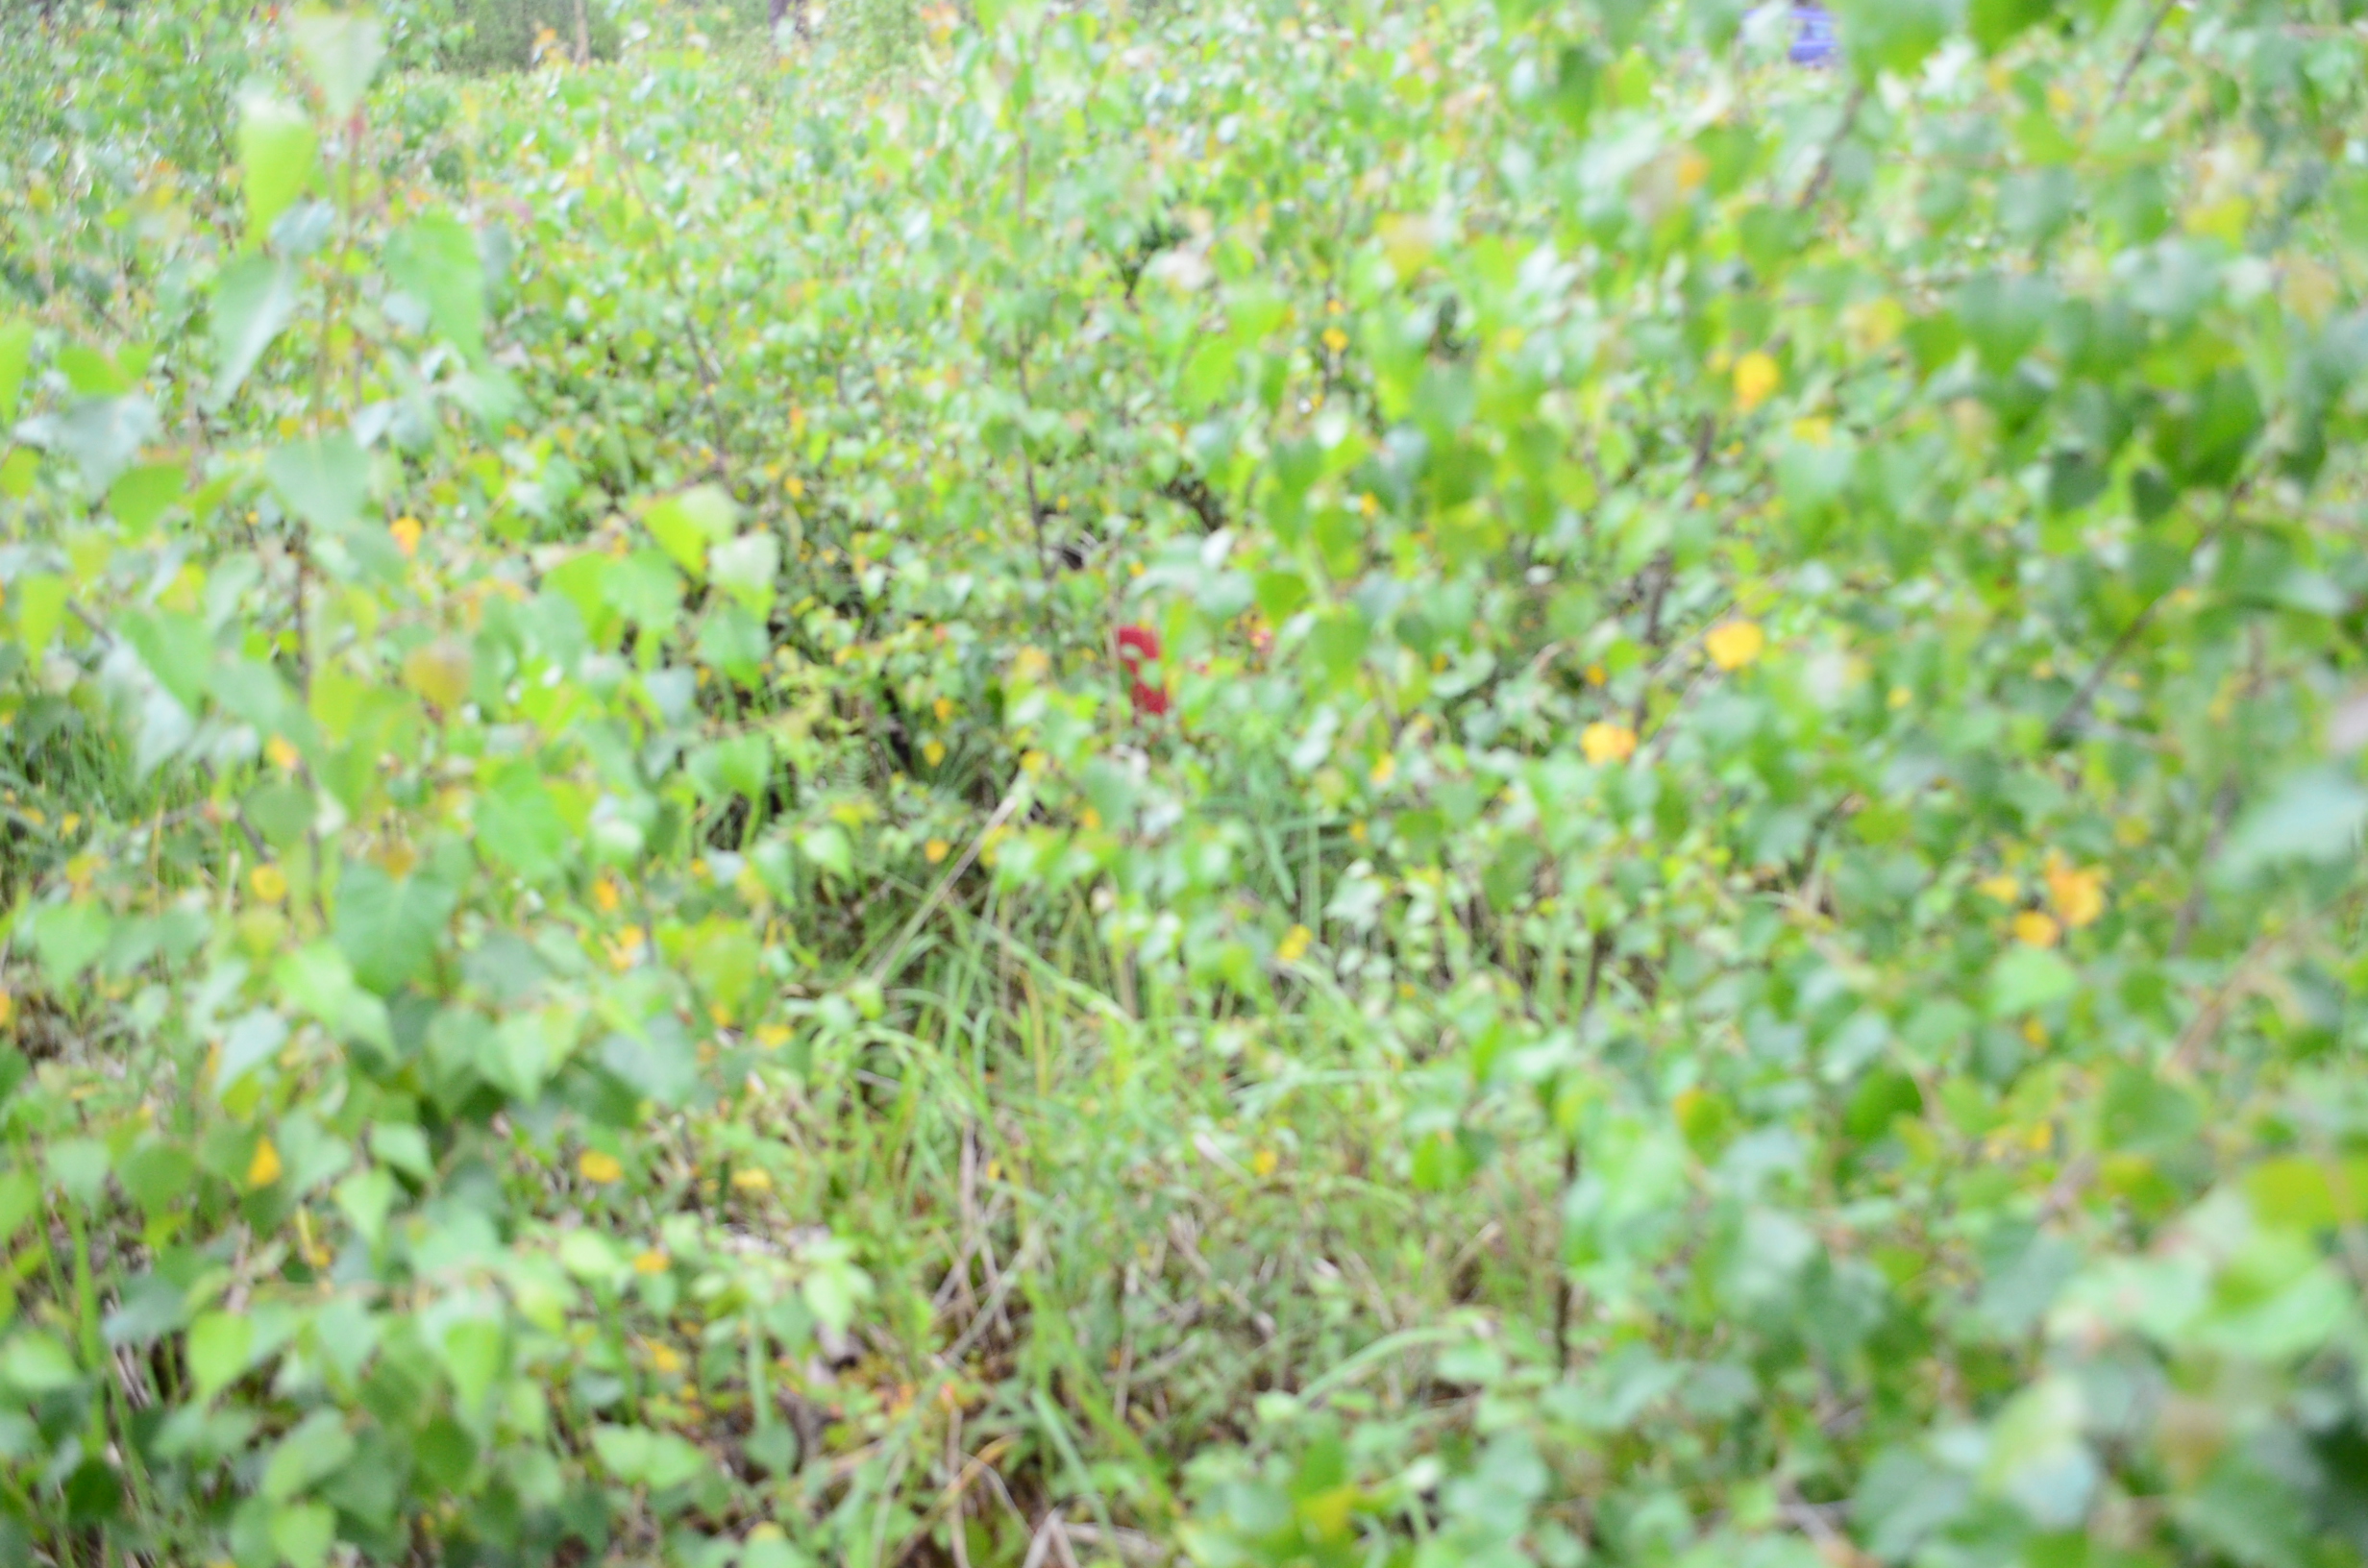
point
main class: Woodland
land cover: Pine dominated mixed woodland
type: hemiboreal forest and nemoral coniferous forest and mixed broadleaved-coniferous forest
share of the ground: 50 - 75 %
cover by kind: broadleaved forest trees 30 %, shrubs 30 %, coniferous forest trees 25 %, herbaceous plants 15 %
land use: Forestry
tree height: < 5 m
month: July
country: LV
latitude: 57.1326
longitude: 22.3944
